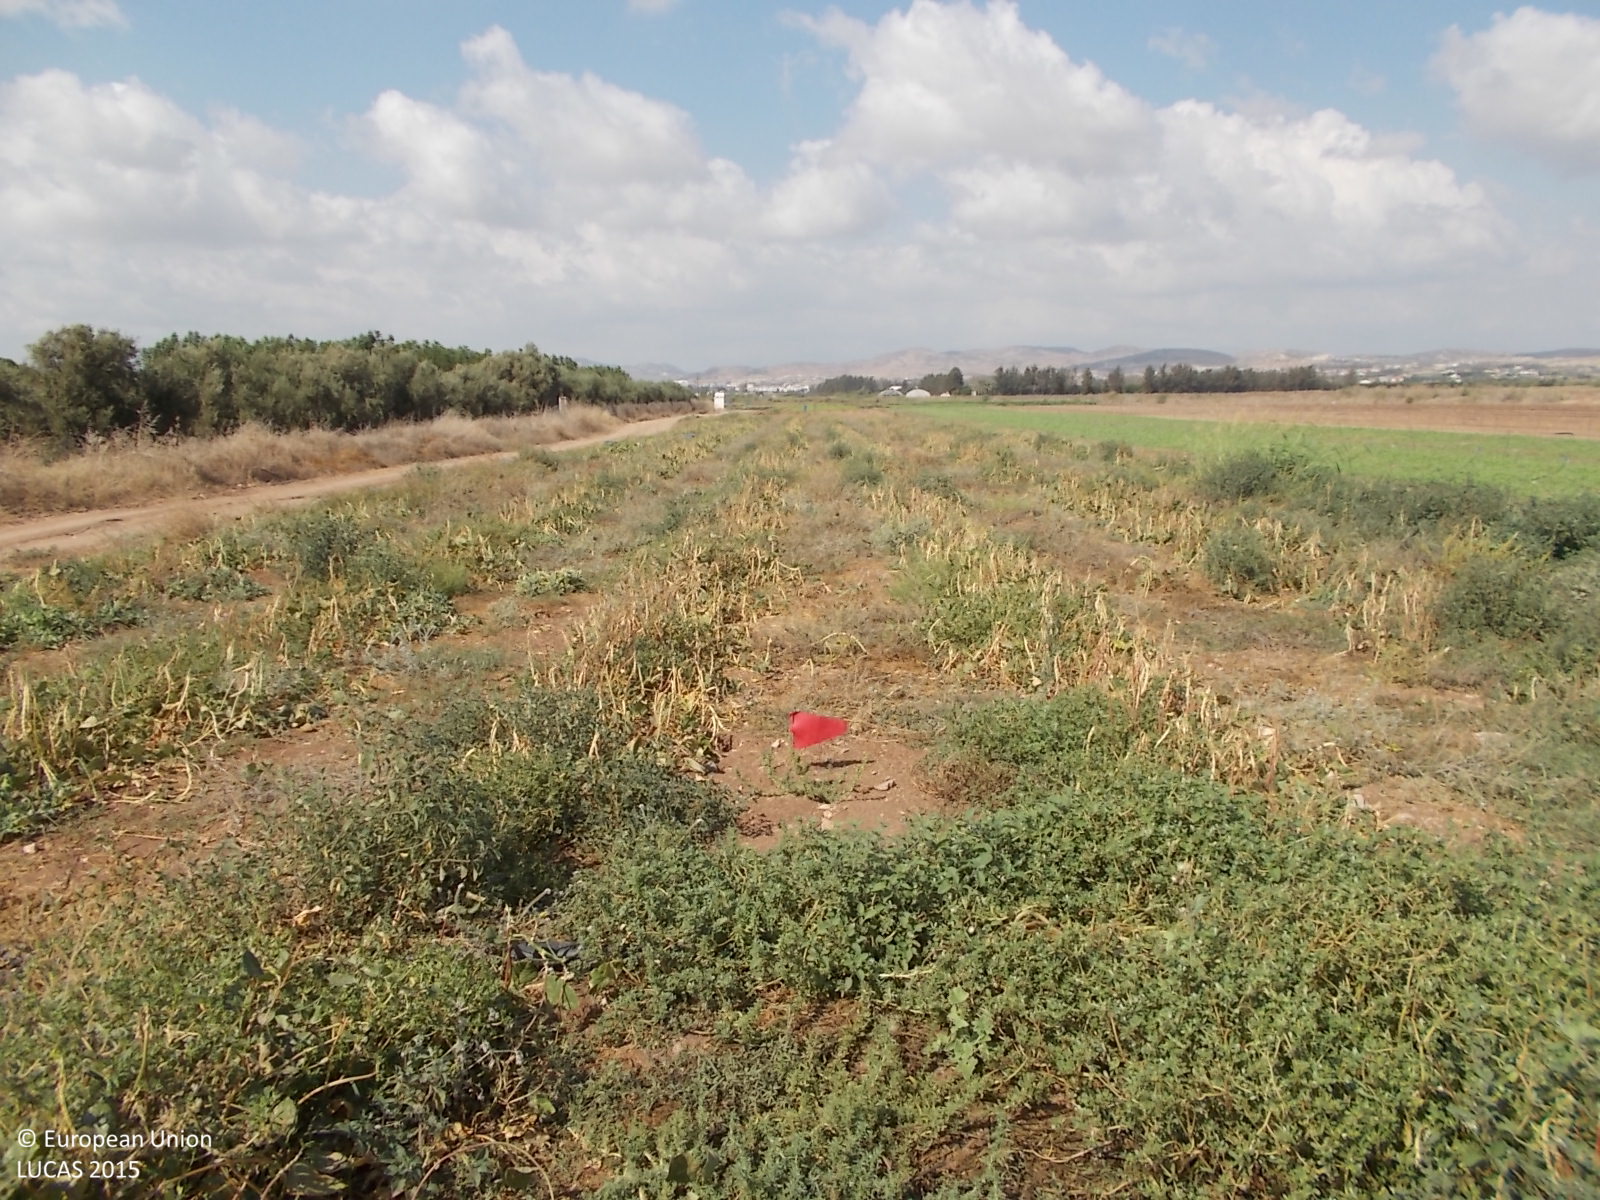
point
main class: Cropland
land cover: Dry pulses
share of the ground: 25 - 50 %
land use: Agriculture (excluding fallow land and kitchen gardens)
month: May
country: CY
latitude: 34.7099
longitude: 32.5177
